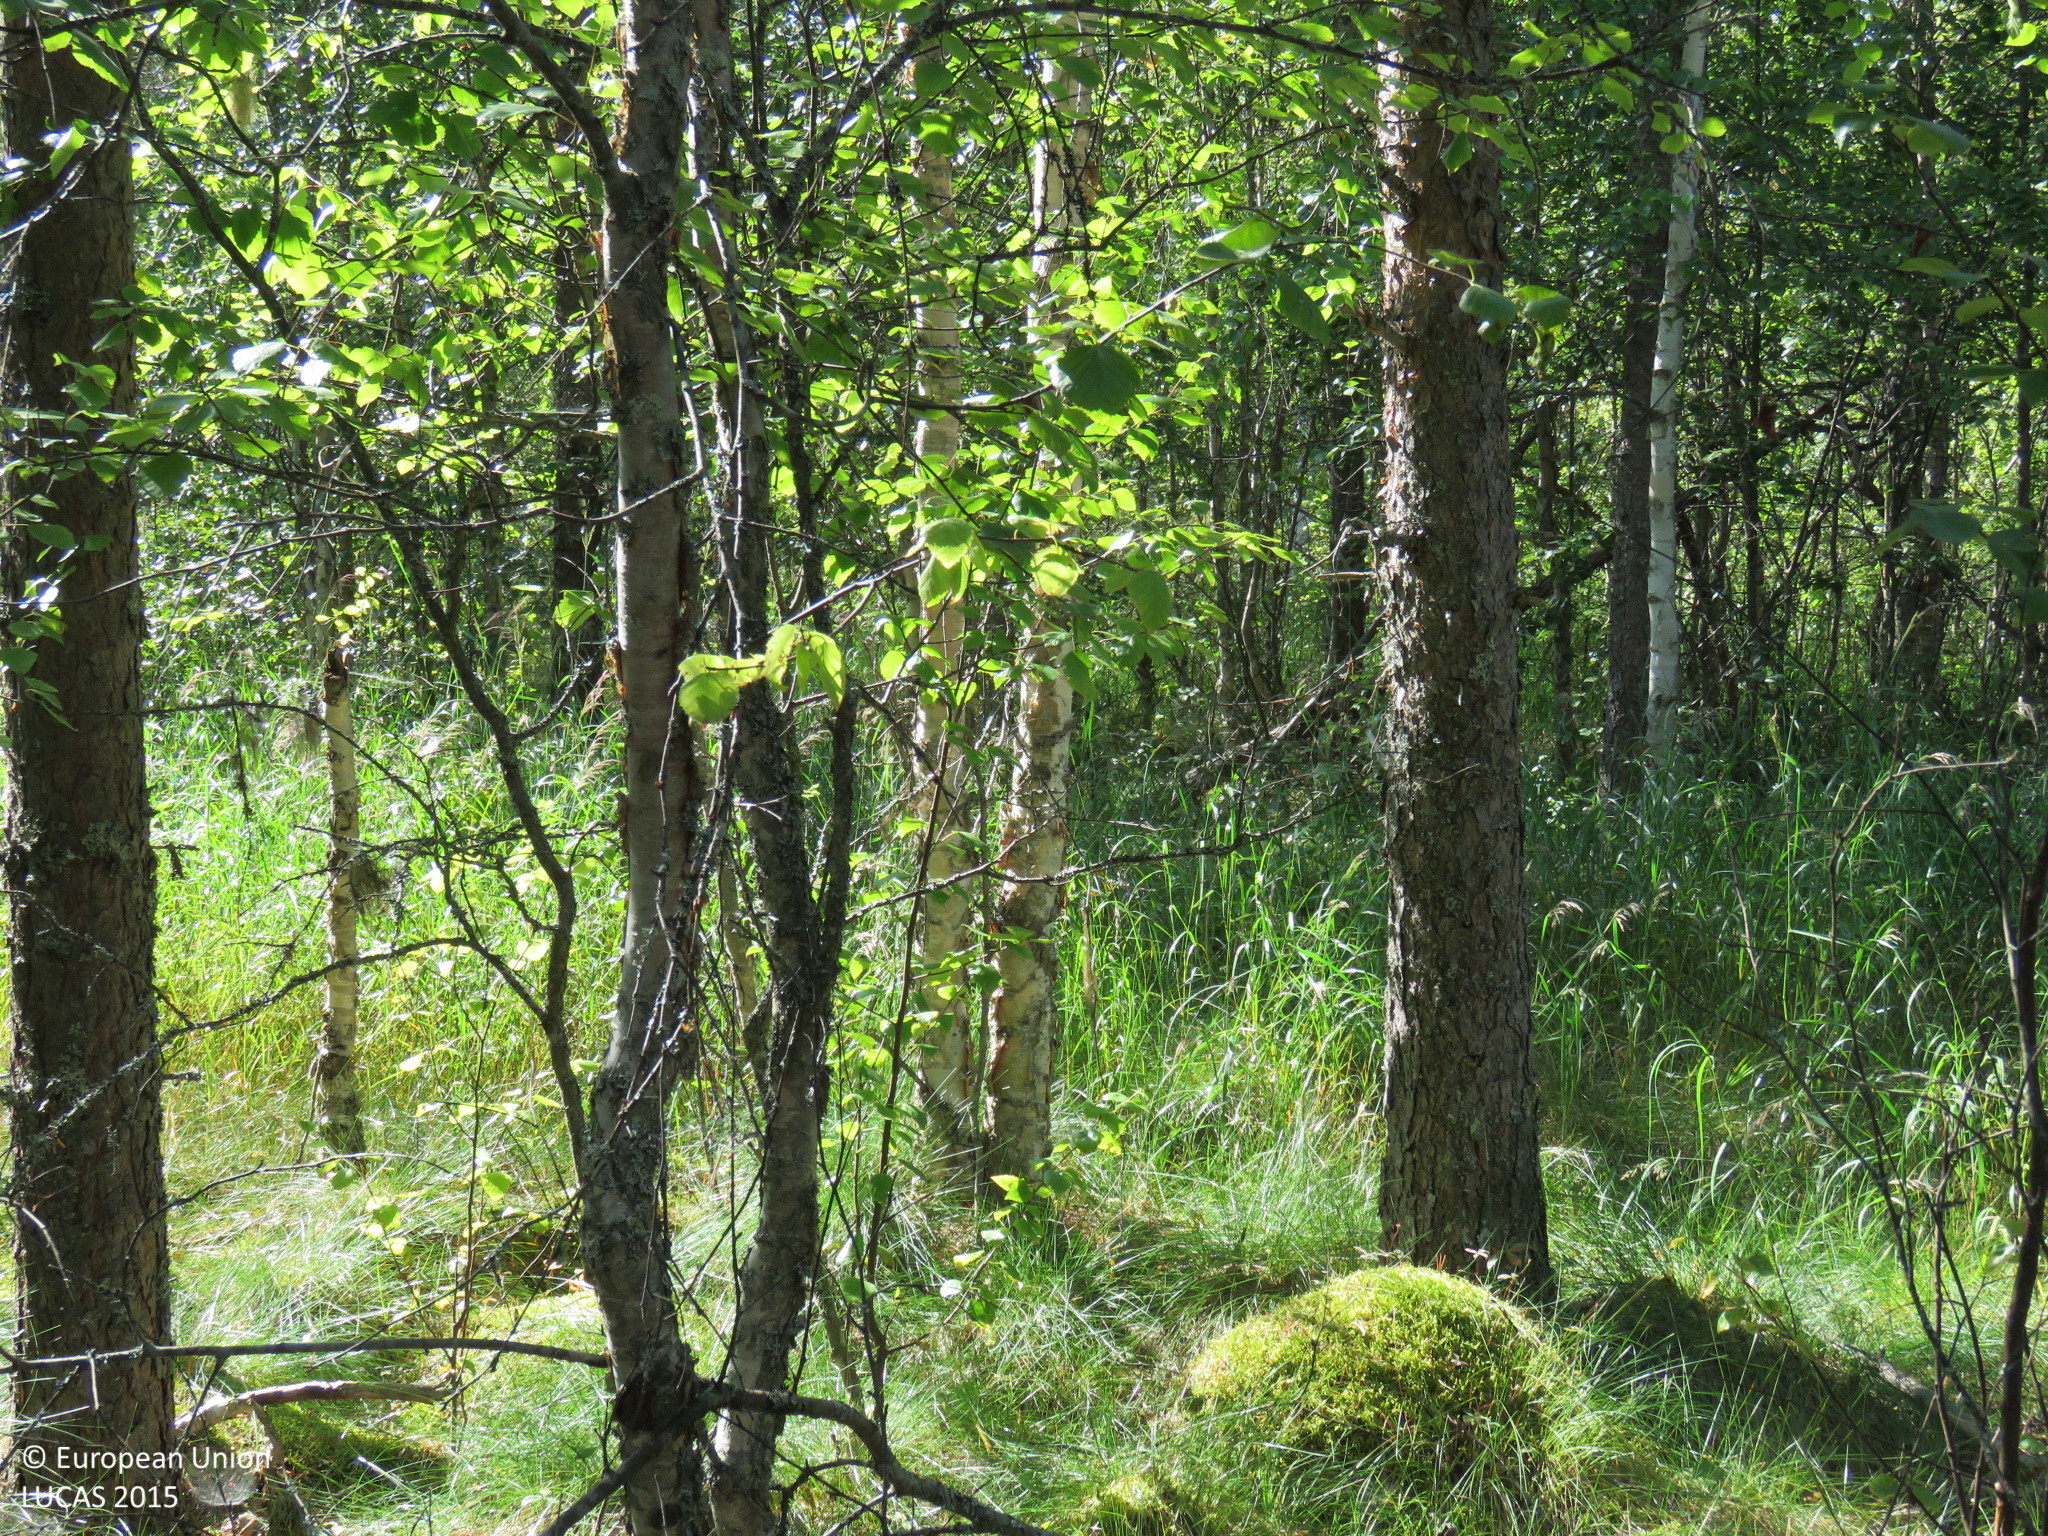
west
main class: Woodland
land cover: Pine dominated mixed woodland
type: mire and swamp forests
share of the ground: > 75 %
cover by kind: broadleaved forest trees 45 %, coniferous forest trees 35 %, herbaceous plants 10 %, shrubs 5 %, lichens and mosses 5 %
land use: Forestry
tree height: > 5 m
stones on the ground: < 10 %
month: July
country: FI
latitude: 64.7243
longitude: 26.2039
